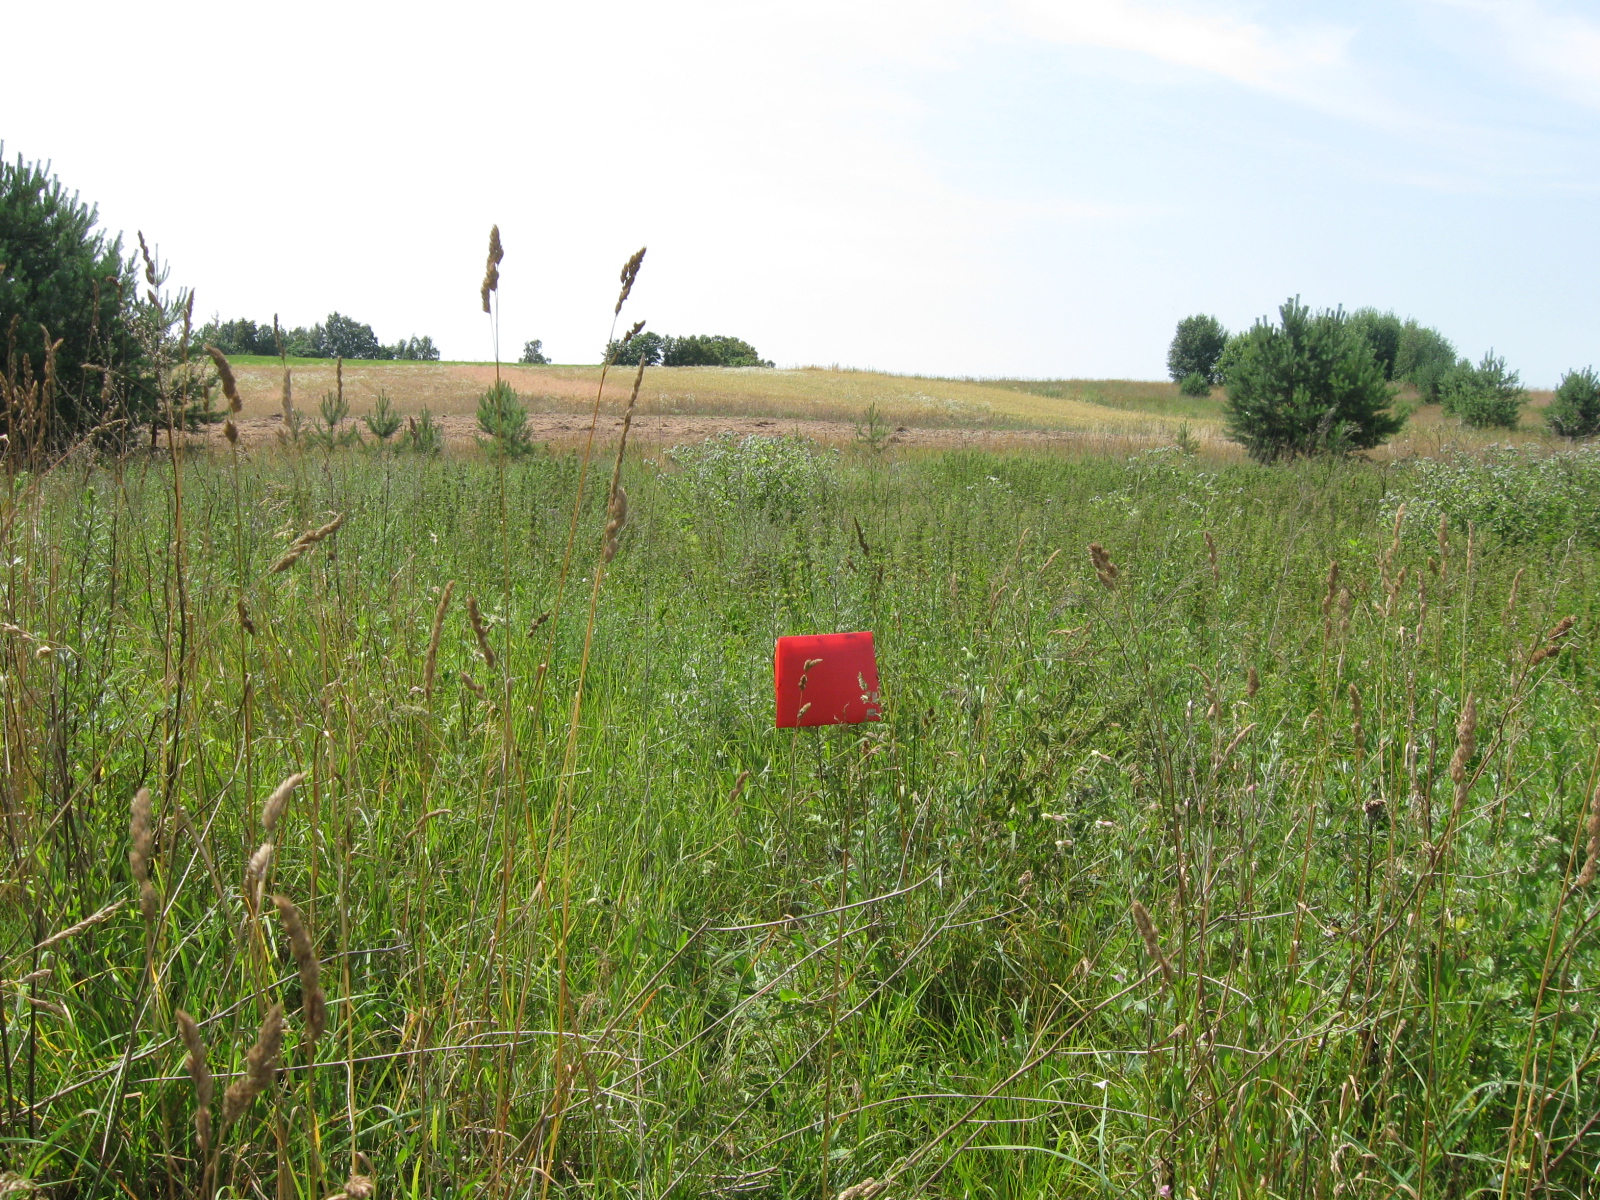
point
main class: Grassland
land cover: Spontaneously vegetated surfaces
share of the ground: > 75 %
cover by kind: herbaceous plants 100 %
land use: Fallow land
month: July
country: LT
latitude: 54.7079
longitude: 23.9502
